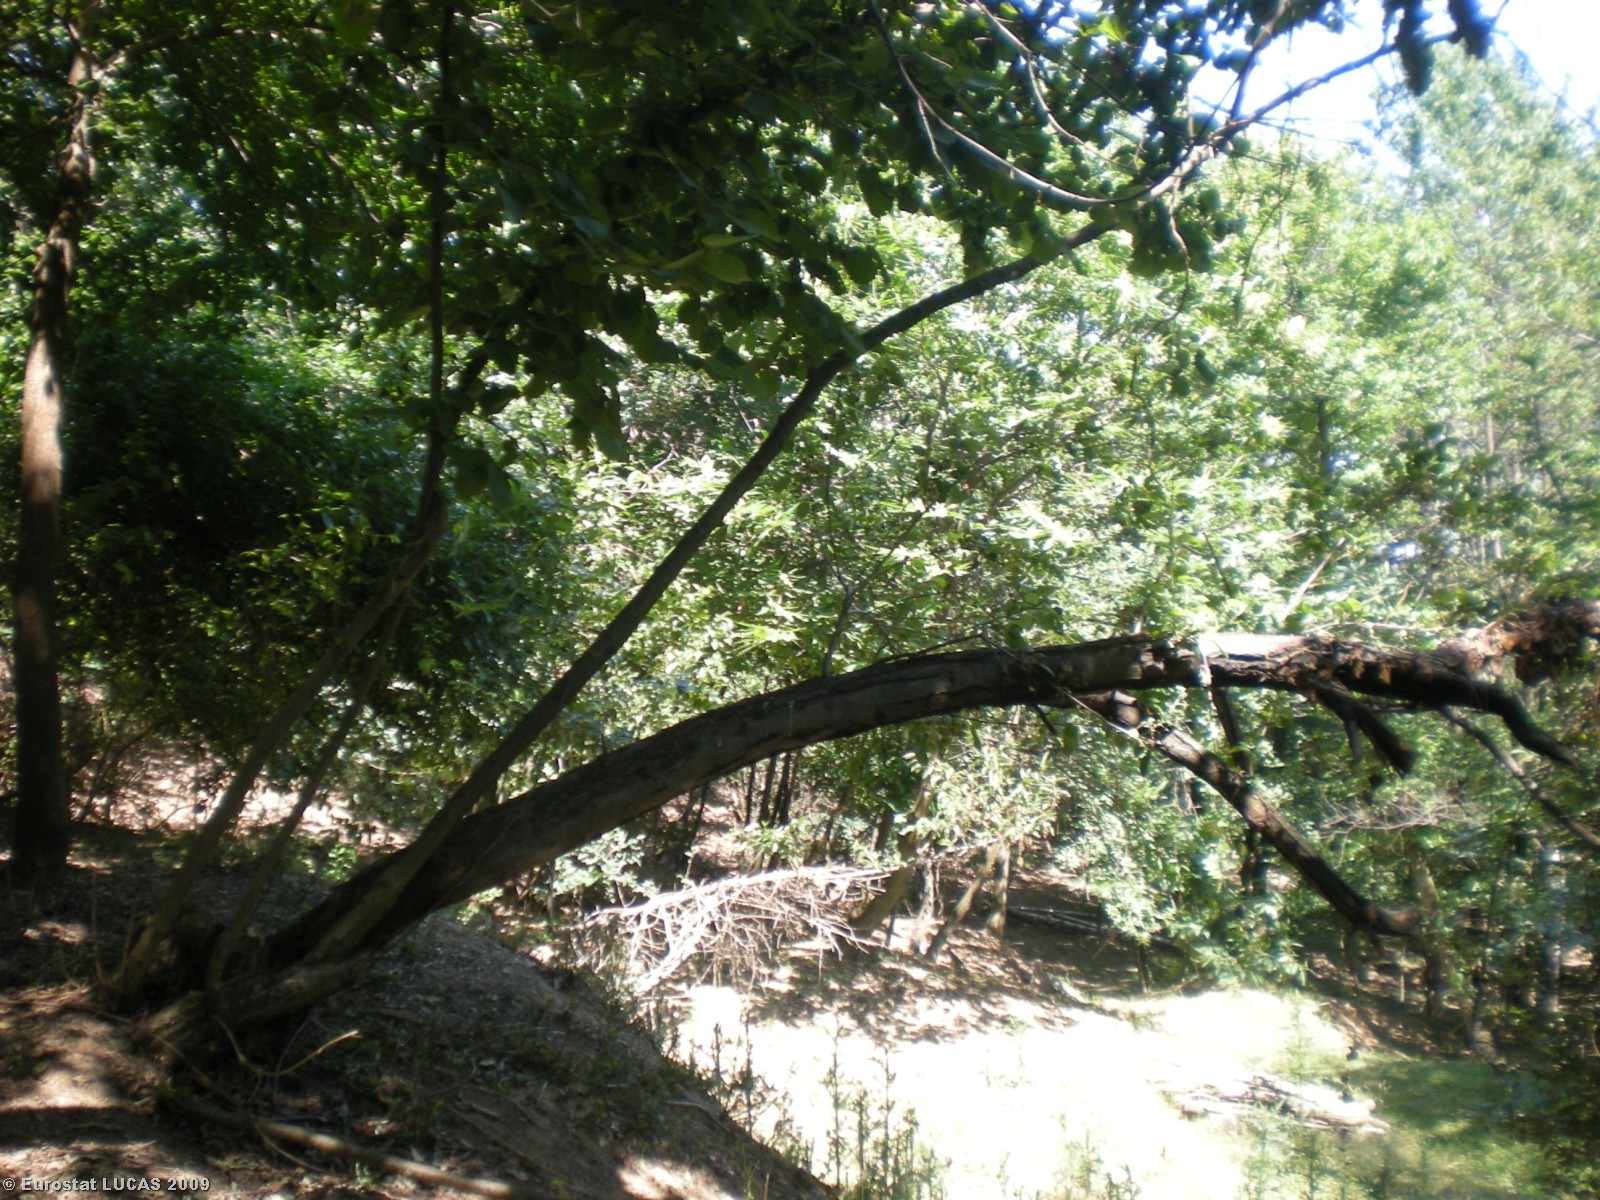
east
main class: Woodland
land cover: Broadleaved woodland
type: mesophytic deciduous forest
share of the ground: > 75 %
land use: Forestry
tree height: > 5 m
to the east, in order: Broadleaved woodland; Fences; Broadleaved woodland; Tracks; Broadleaved woodland; Tracks
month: June
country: IT
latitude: 44.4991
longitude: 7.4270
